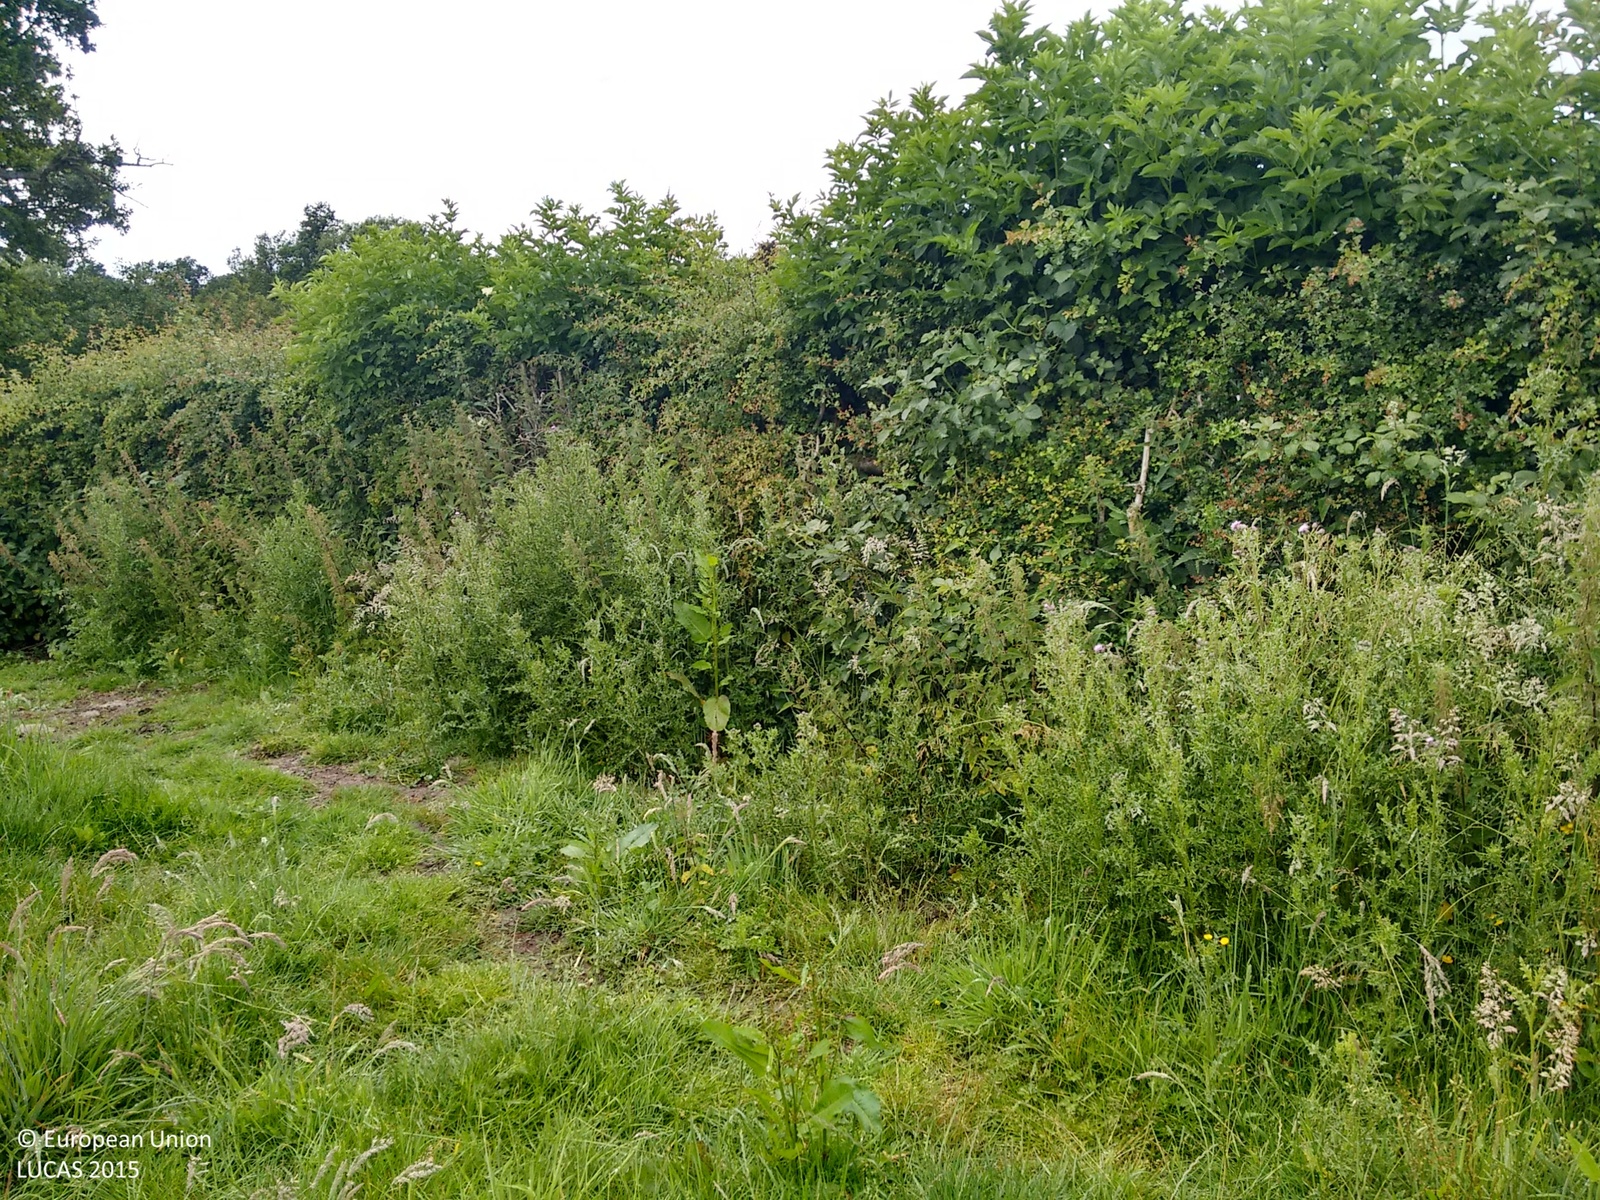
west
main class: Grassland
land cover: Grassland without tree/shrub cover
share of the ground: > 75 %
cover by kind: herbaceous plants 100 %
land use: Agriculture (excluding fallow land and kitchen gardens)
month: June
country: GB
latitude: 50.9273
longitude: 0.2812
